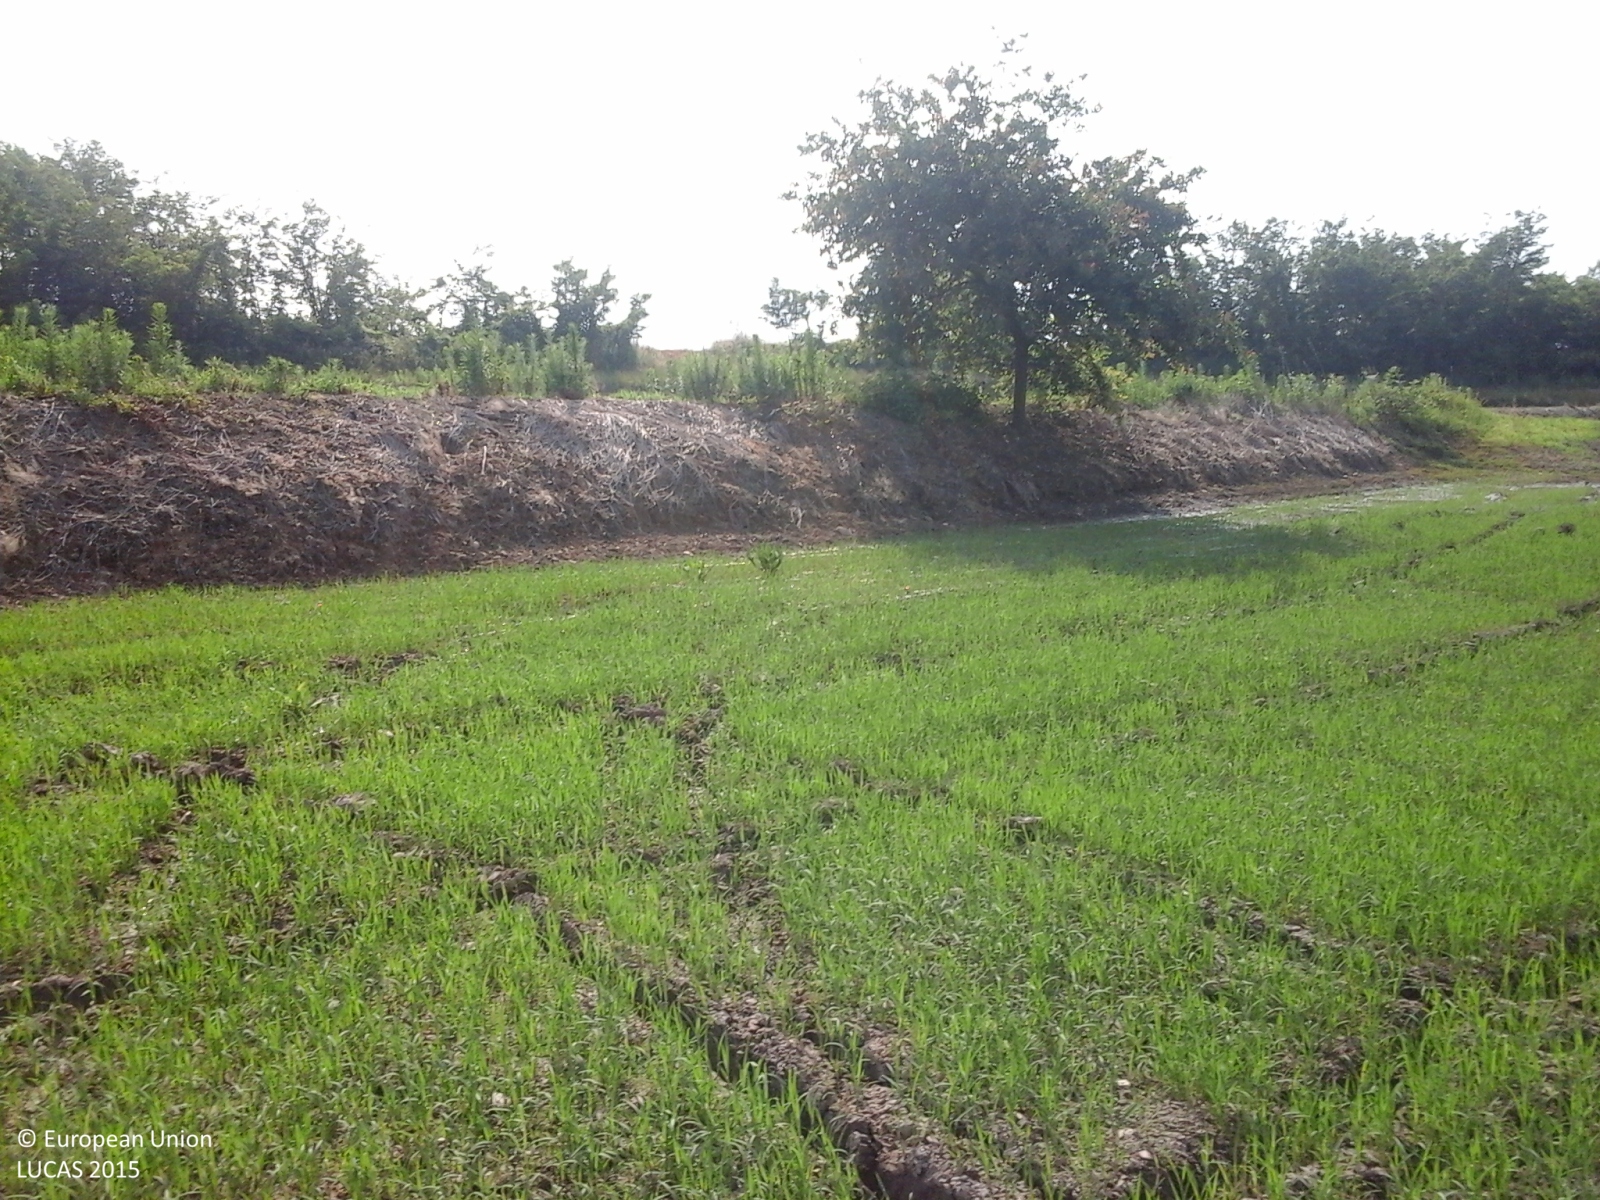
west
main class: Cropland
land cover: Rice
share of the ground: 10 - 25 %
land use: Agriculture (excluding fallow land and kitchen gardens)
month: June
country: IT
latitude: 45.4731
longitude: 8.3271
